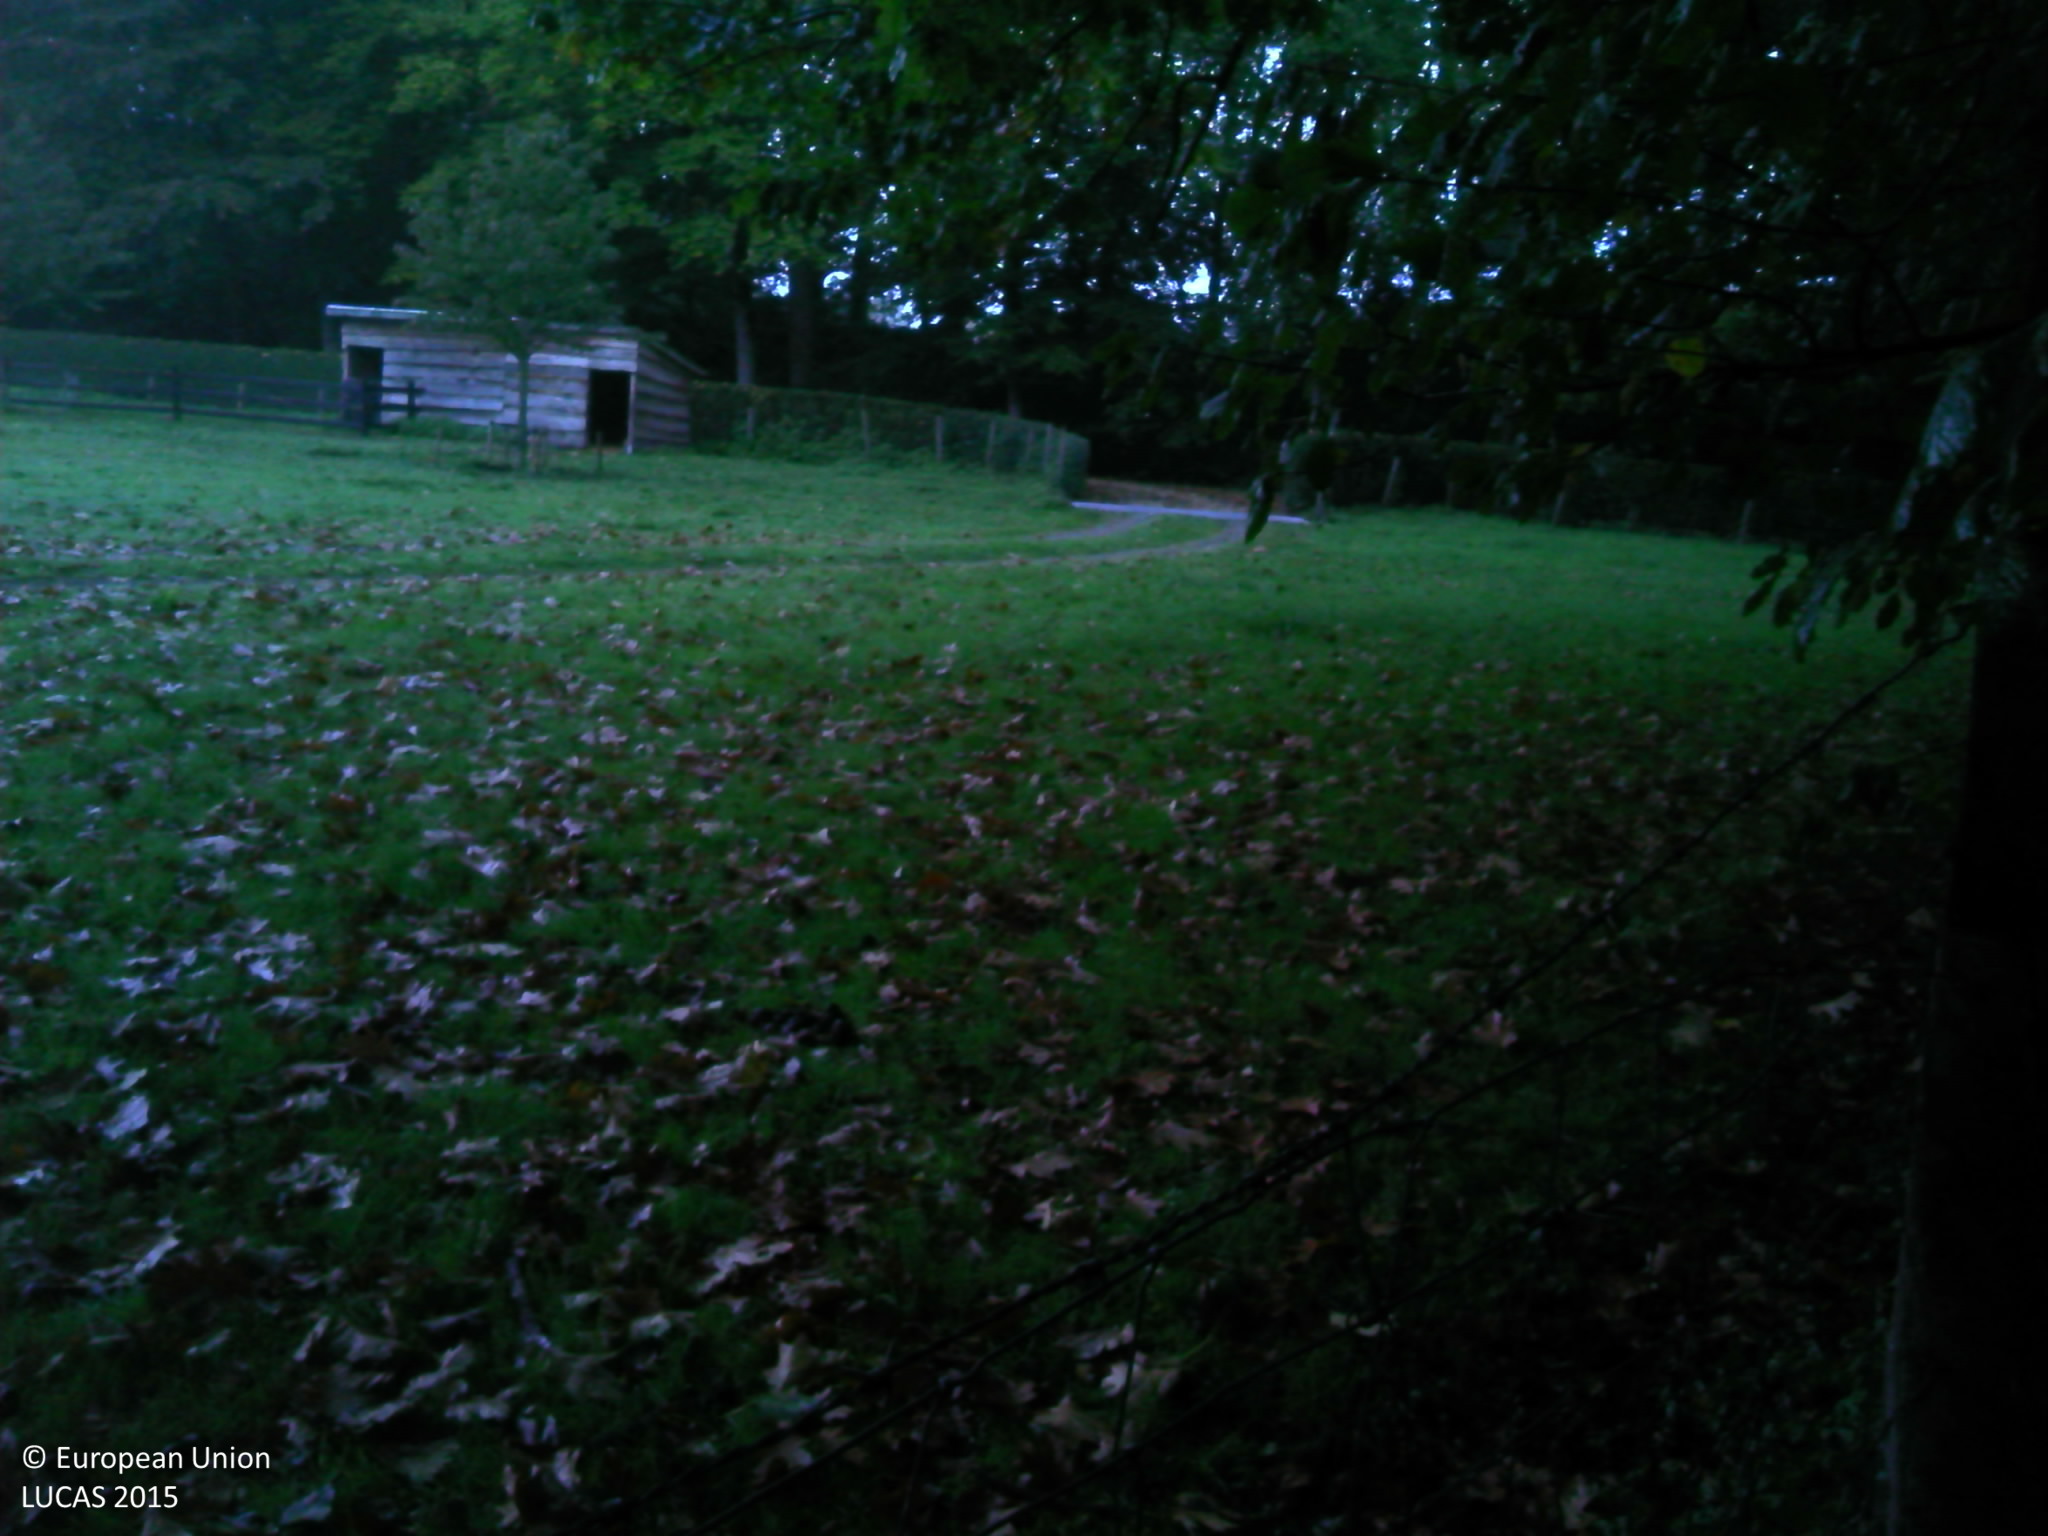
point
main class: Grassland
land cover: Grassland without tree/shrub cover
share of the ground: > 75 %
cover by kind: herbaceous plants 100 %
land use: Residential
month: October
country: BE
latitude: 51.3269
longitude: 4.4129
